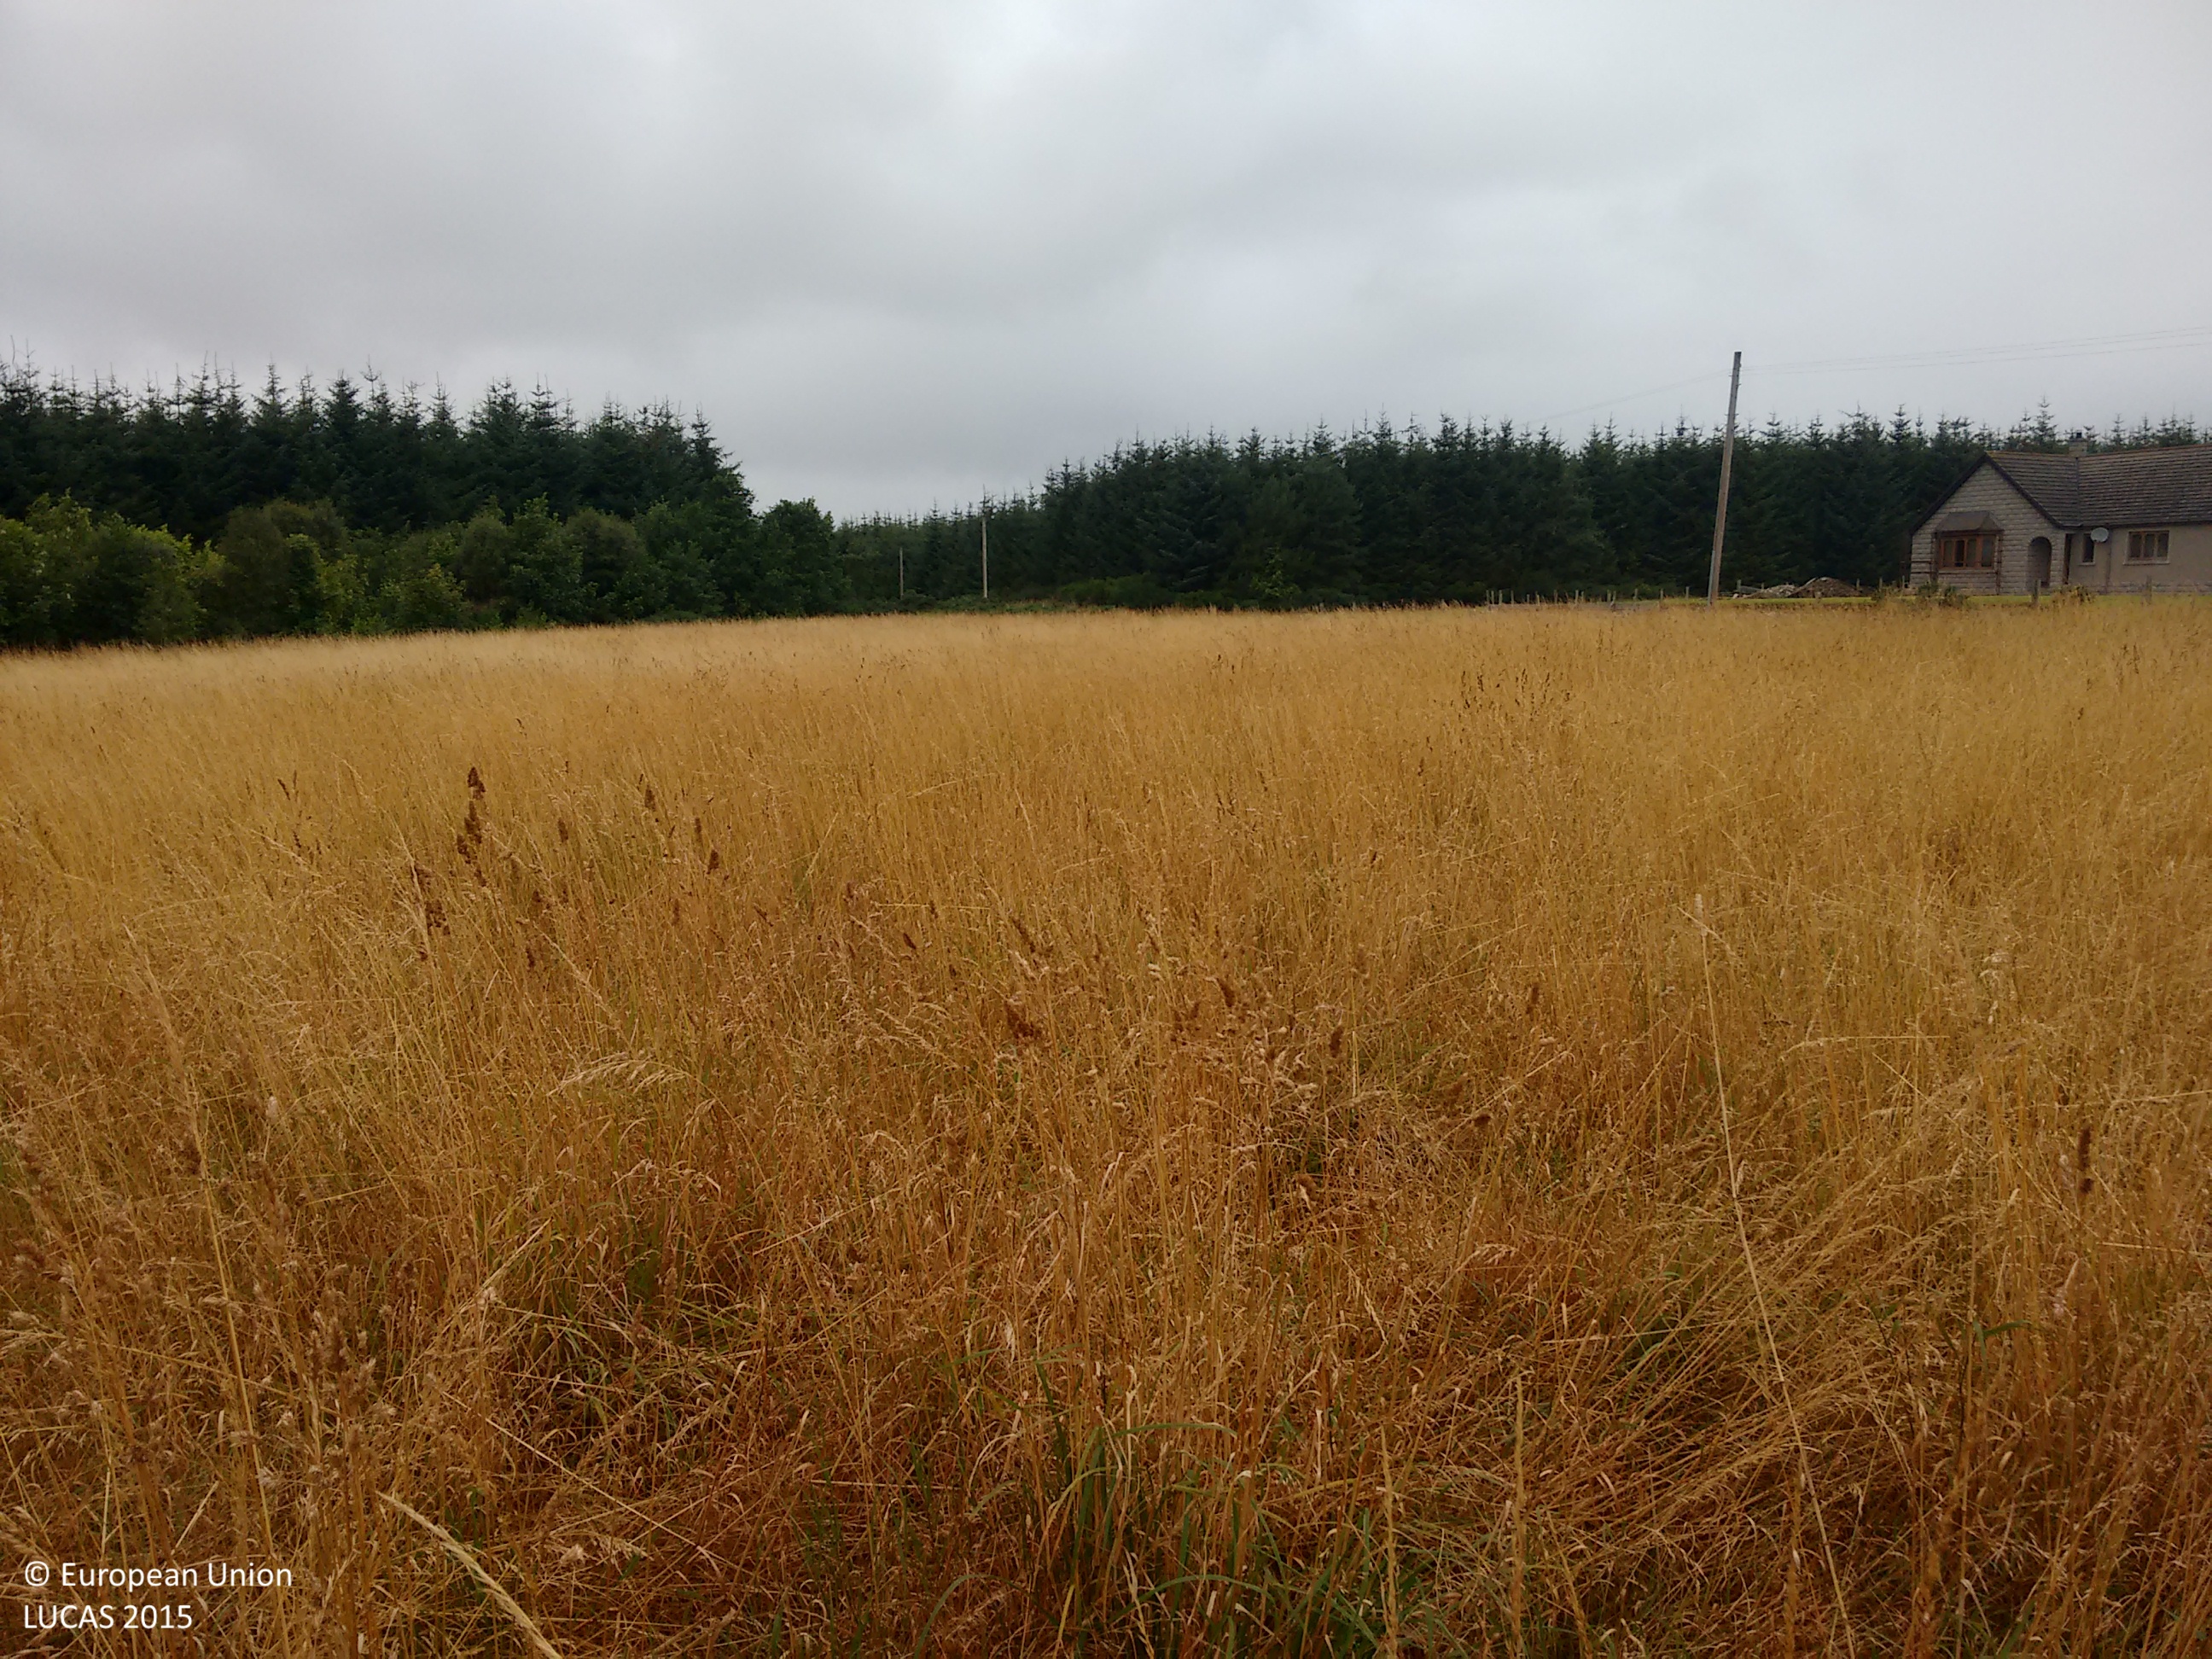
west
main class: Grassland
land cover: Grassland without tree/shrub cover
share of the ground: > 75 %
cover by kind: herbaceous plants 100 %
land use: Agriculture (excluding fallow land and kitchen gardens)
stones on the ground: 10 - 25 %
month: September
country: GB
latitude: 57.6867
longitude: -2.8896
